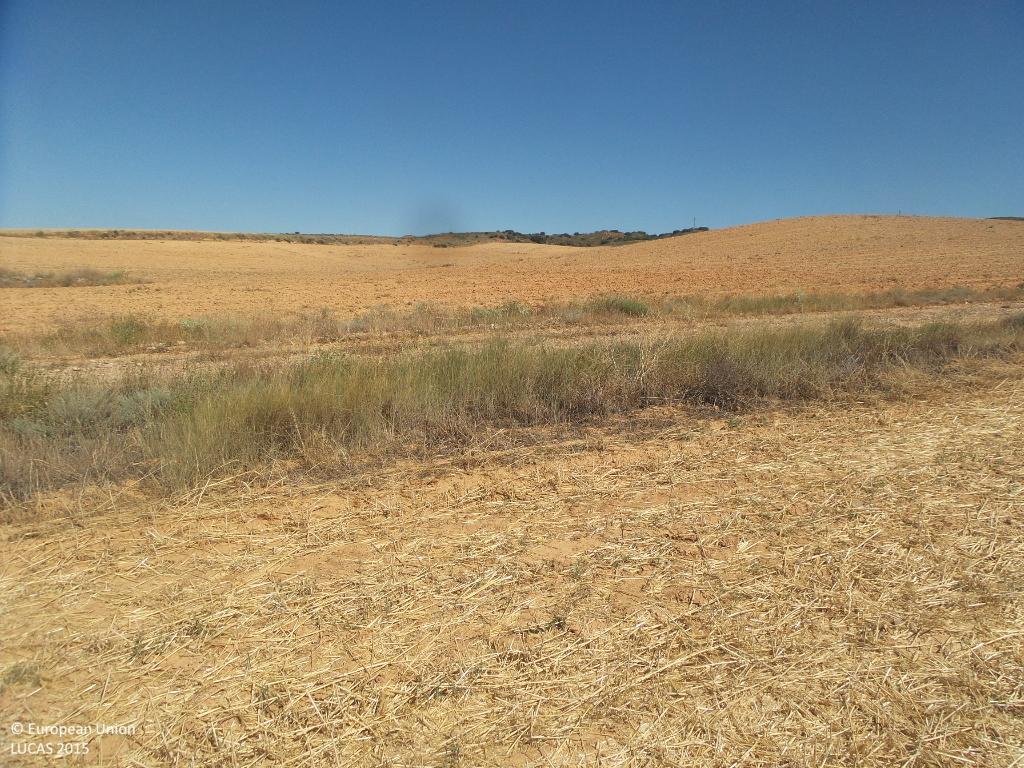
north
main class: Cropland
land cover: Common wheat
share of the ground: < 10 %
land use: Agriculture (excluding fallow land and kitchen gardens)
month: July
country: ES
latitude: 41.3405
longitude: -2.1113
